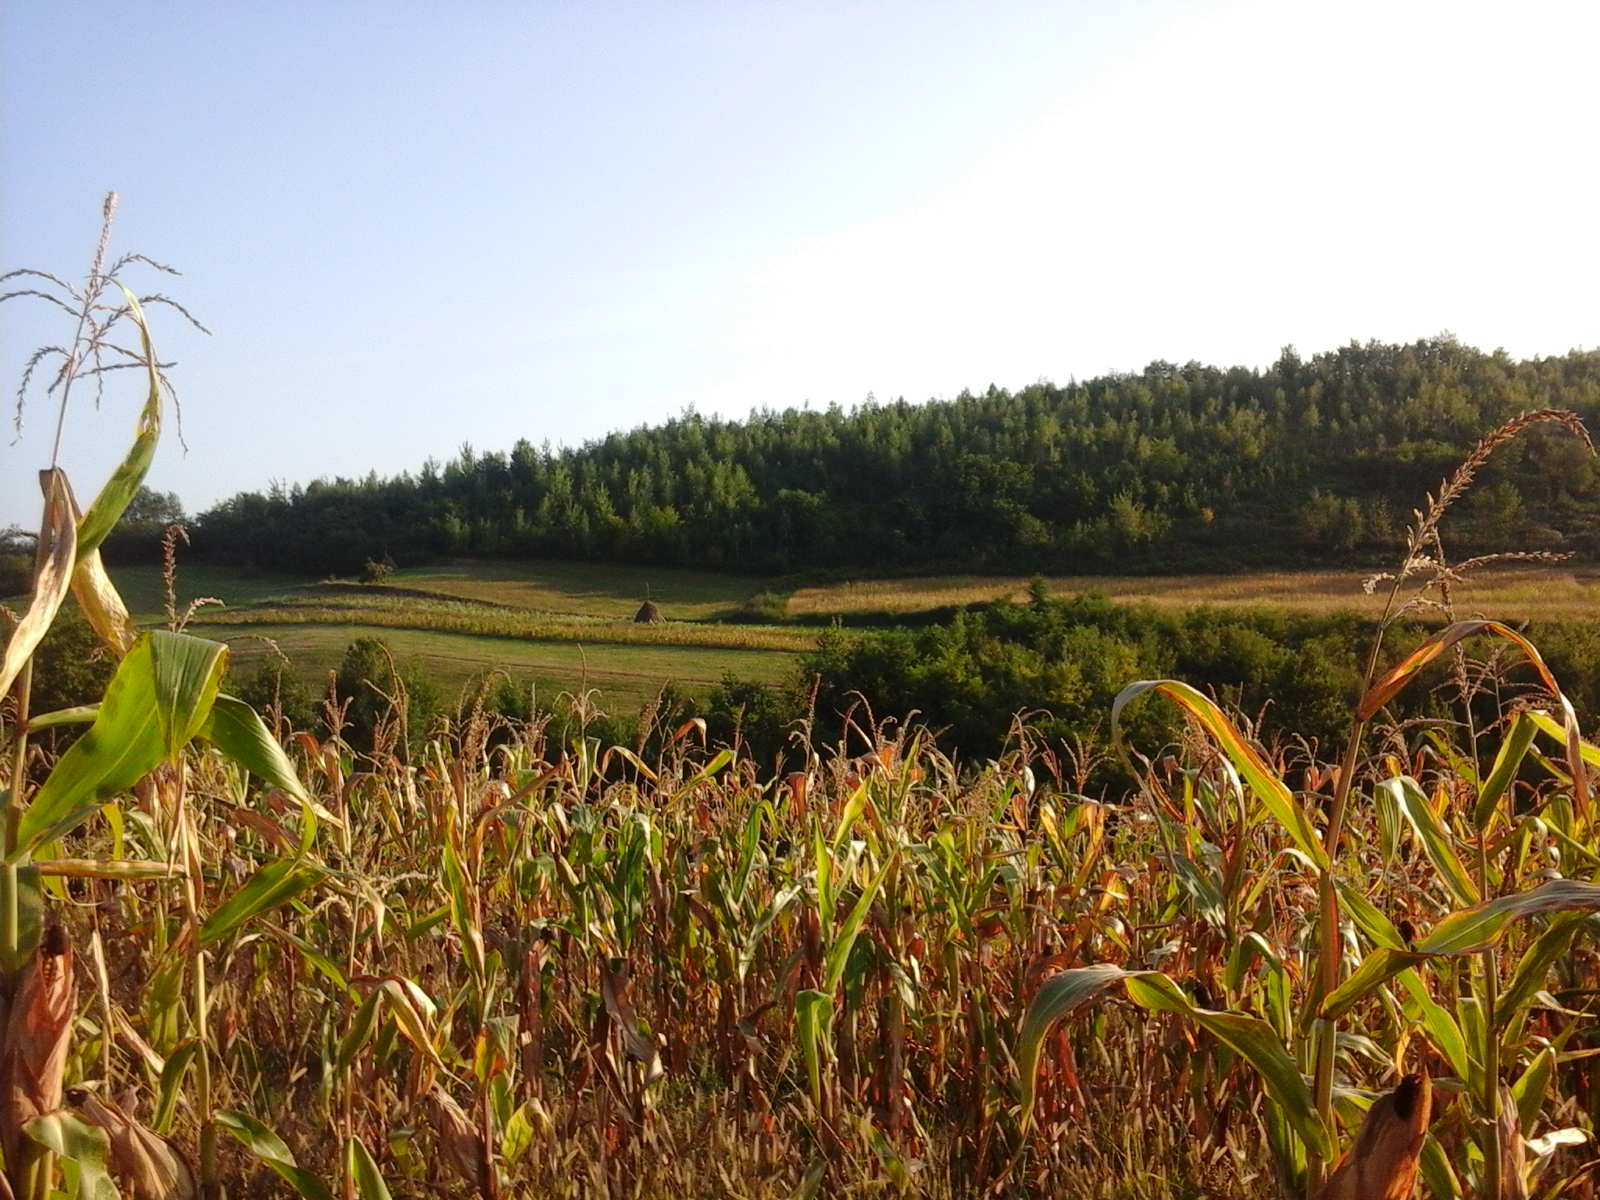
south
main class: Cropland
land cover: Maize
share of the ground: > 75 %
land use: Agriculture (excluding fallow land and kitchen gardens)
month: September
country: RO
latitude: 46.5577
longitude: 22.5355
